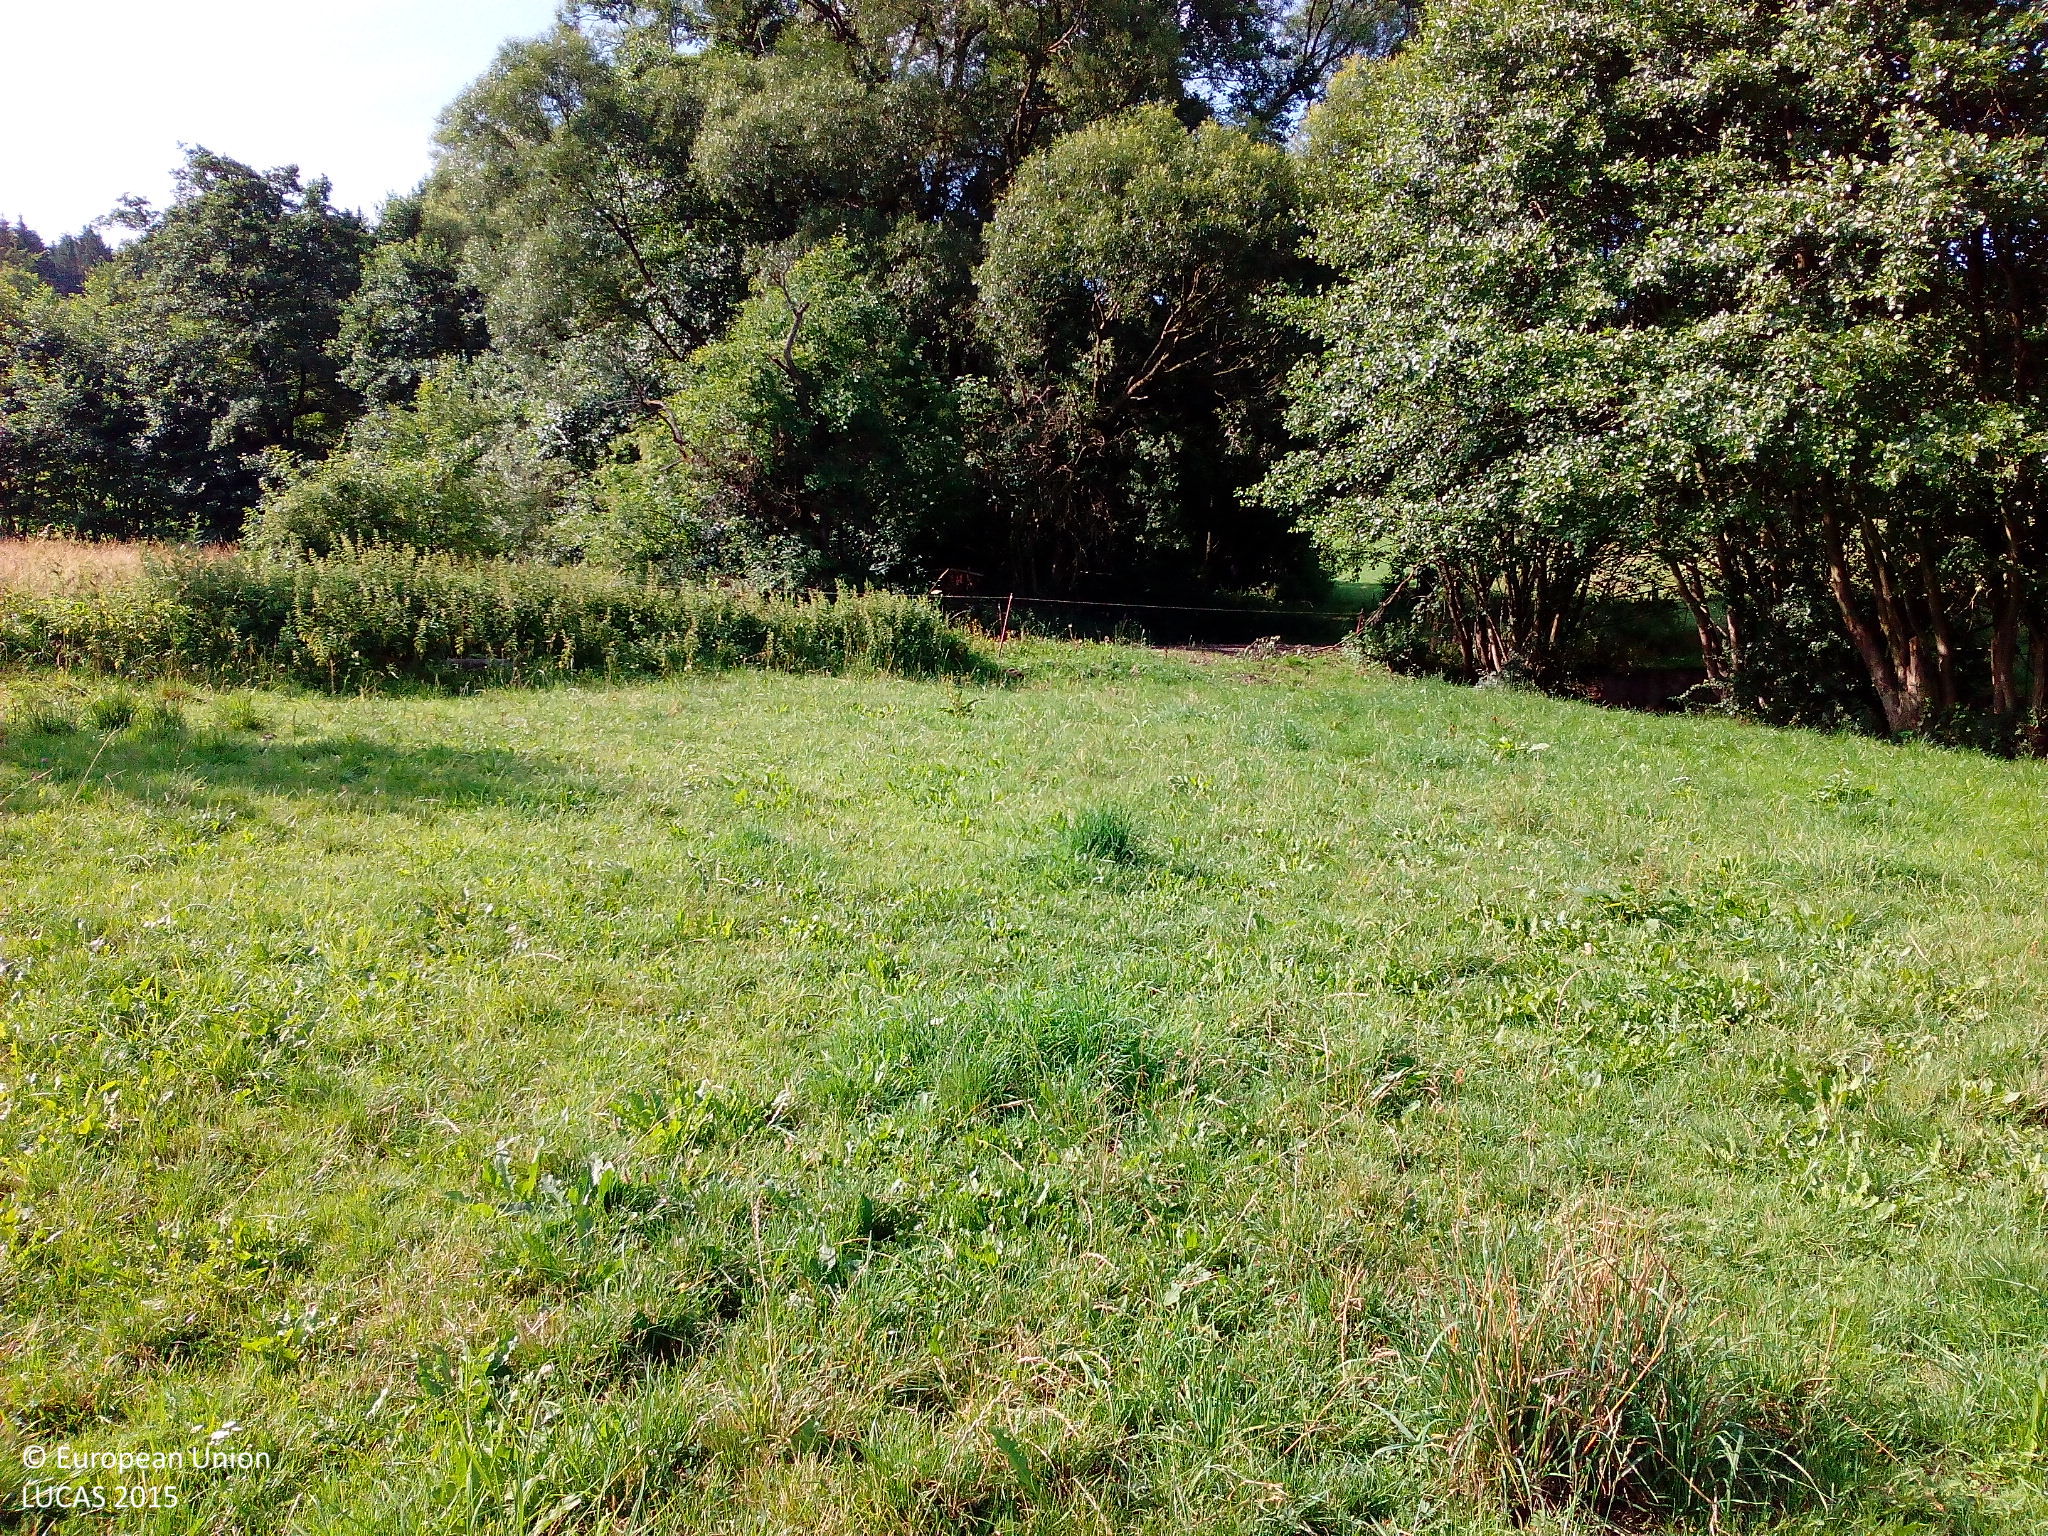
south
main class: Grassland
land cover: Grassland without tree/shrub cover
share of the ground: > 75 %
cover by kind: herbaceous plants 100 %
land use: Agriculture (excluding fallow land and kitchen gardens)
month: July
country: DE
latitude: 50.6517
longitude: 9.9010
